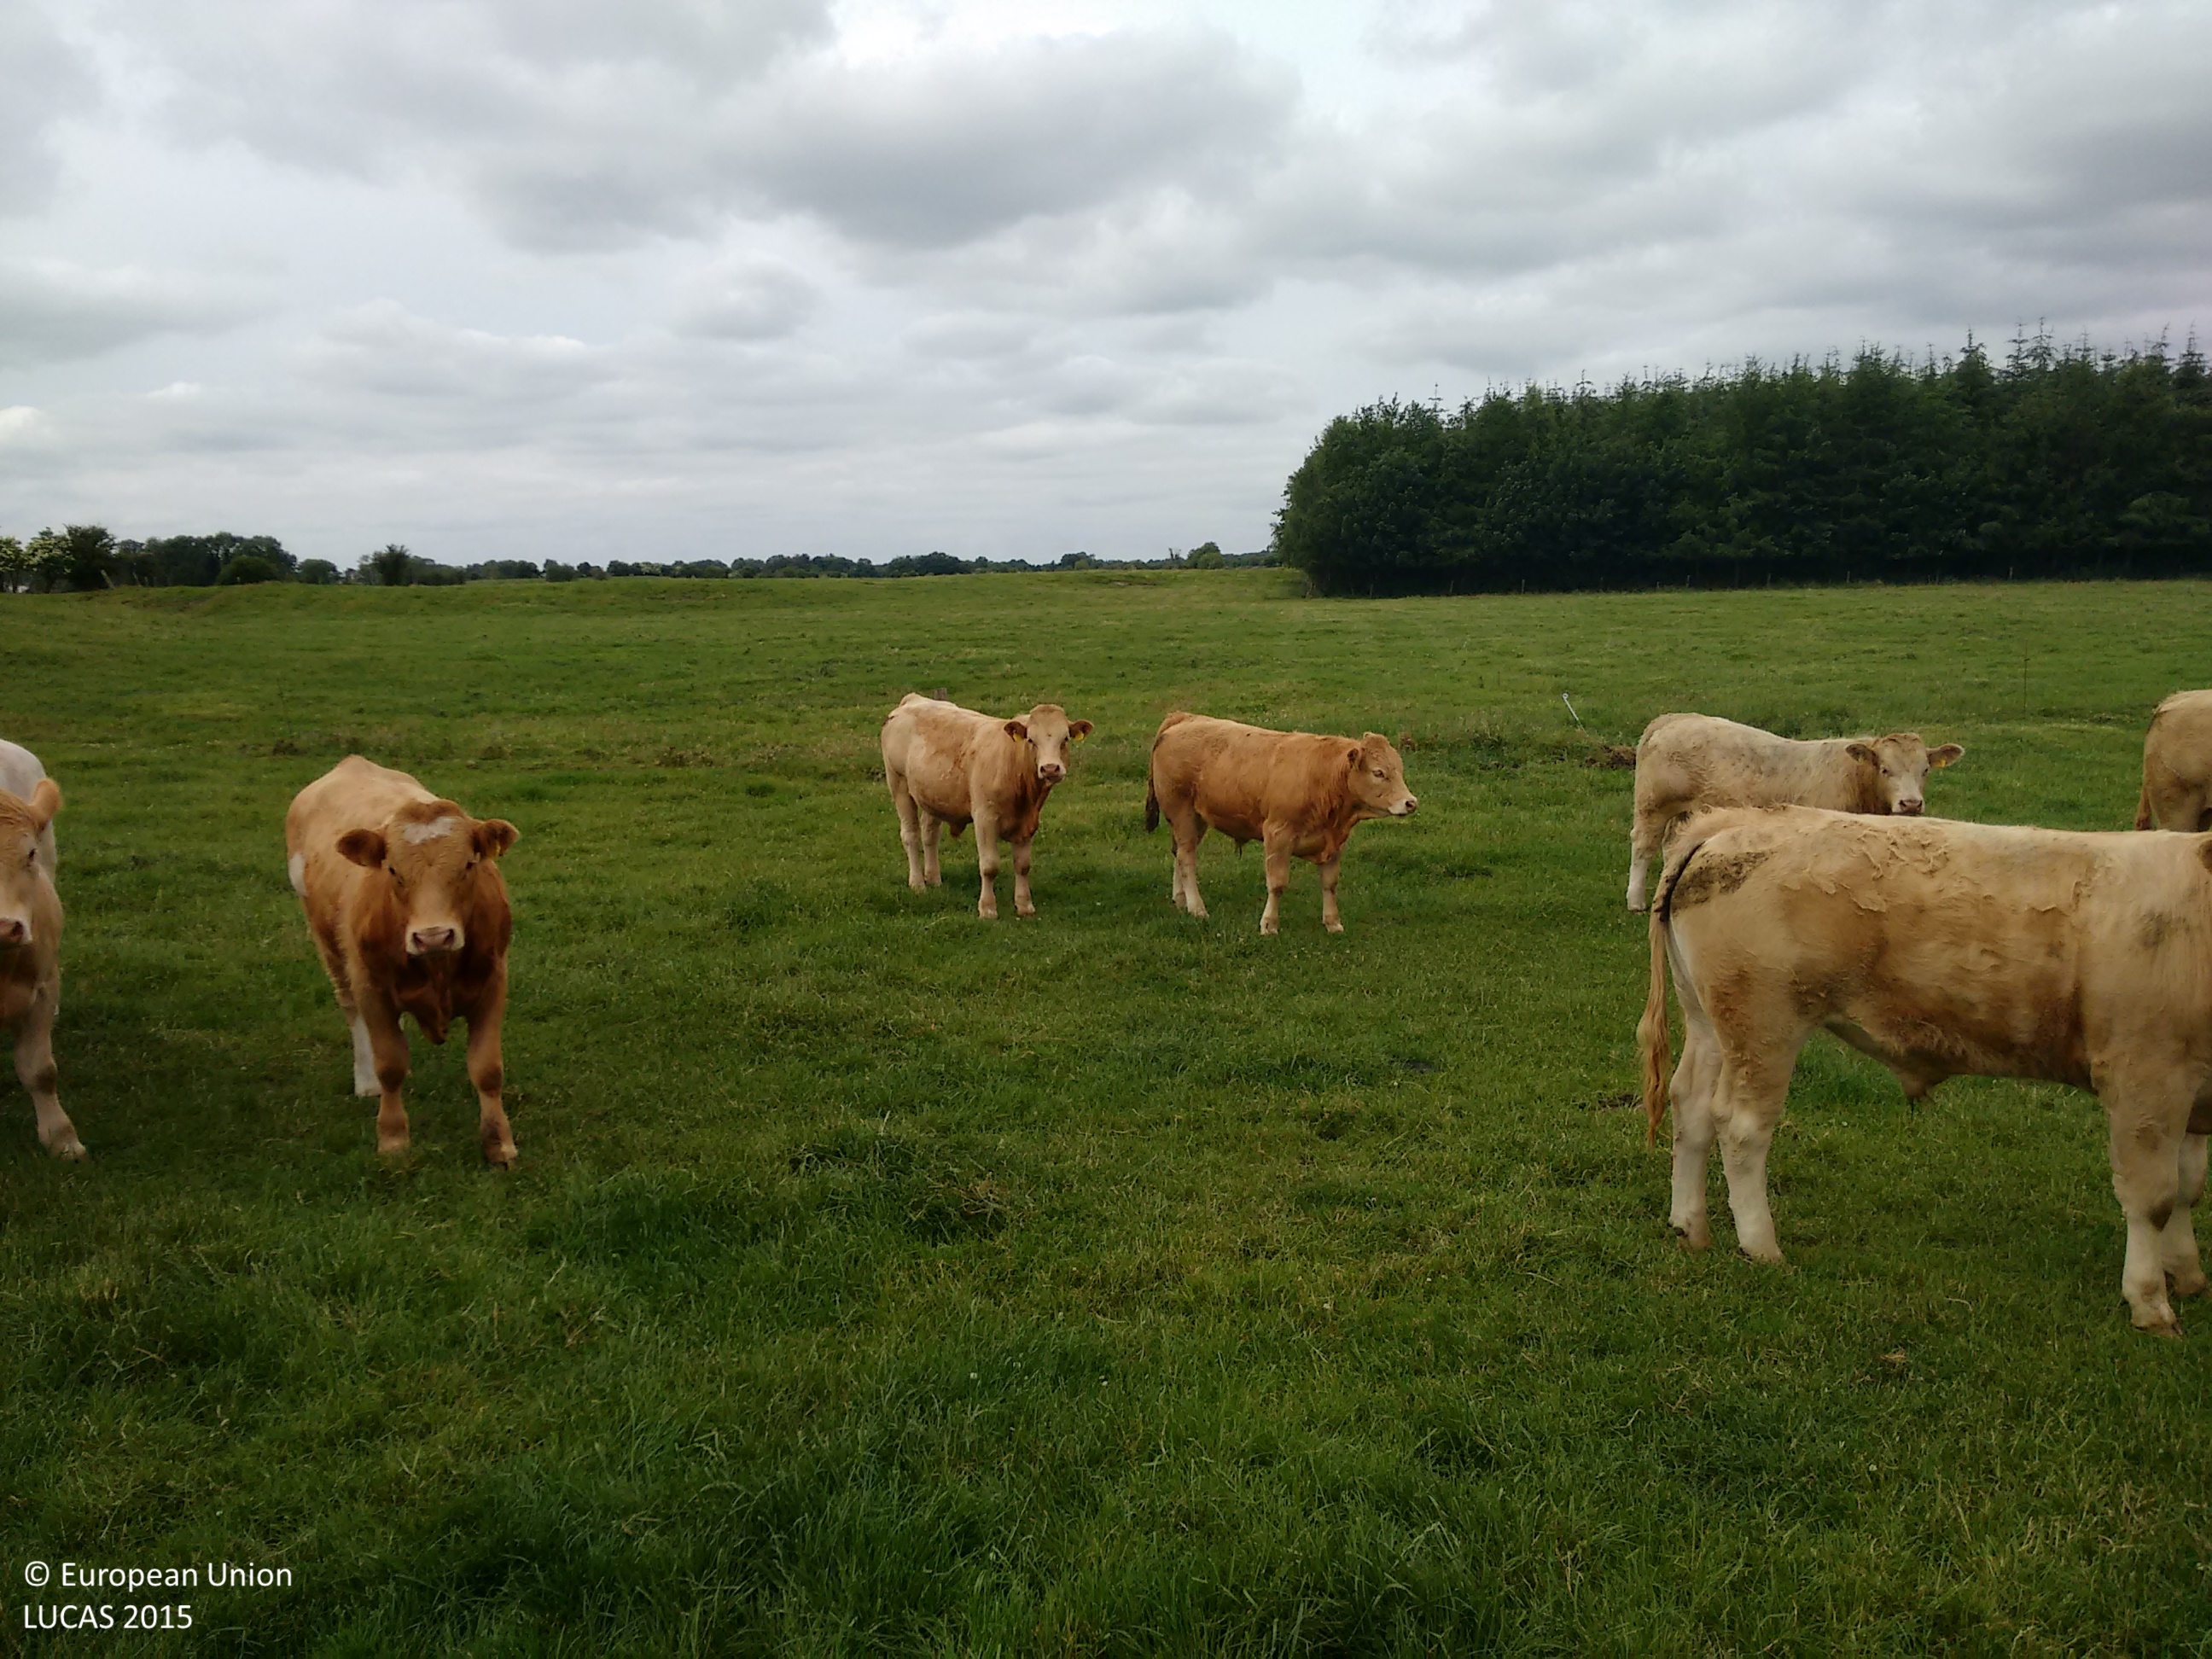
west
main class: Grassland
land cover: Grassland without tree/shrub cover
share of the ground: > 75 %
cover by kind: herbaceous plants 100 %
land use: Agriculture (excluding fallow land and kitchen gardens)
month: July
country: IE
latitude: 53.3587
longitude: -8.0421
